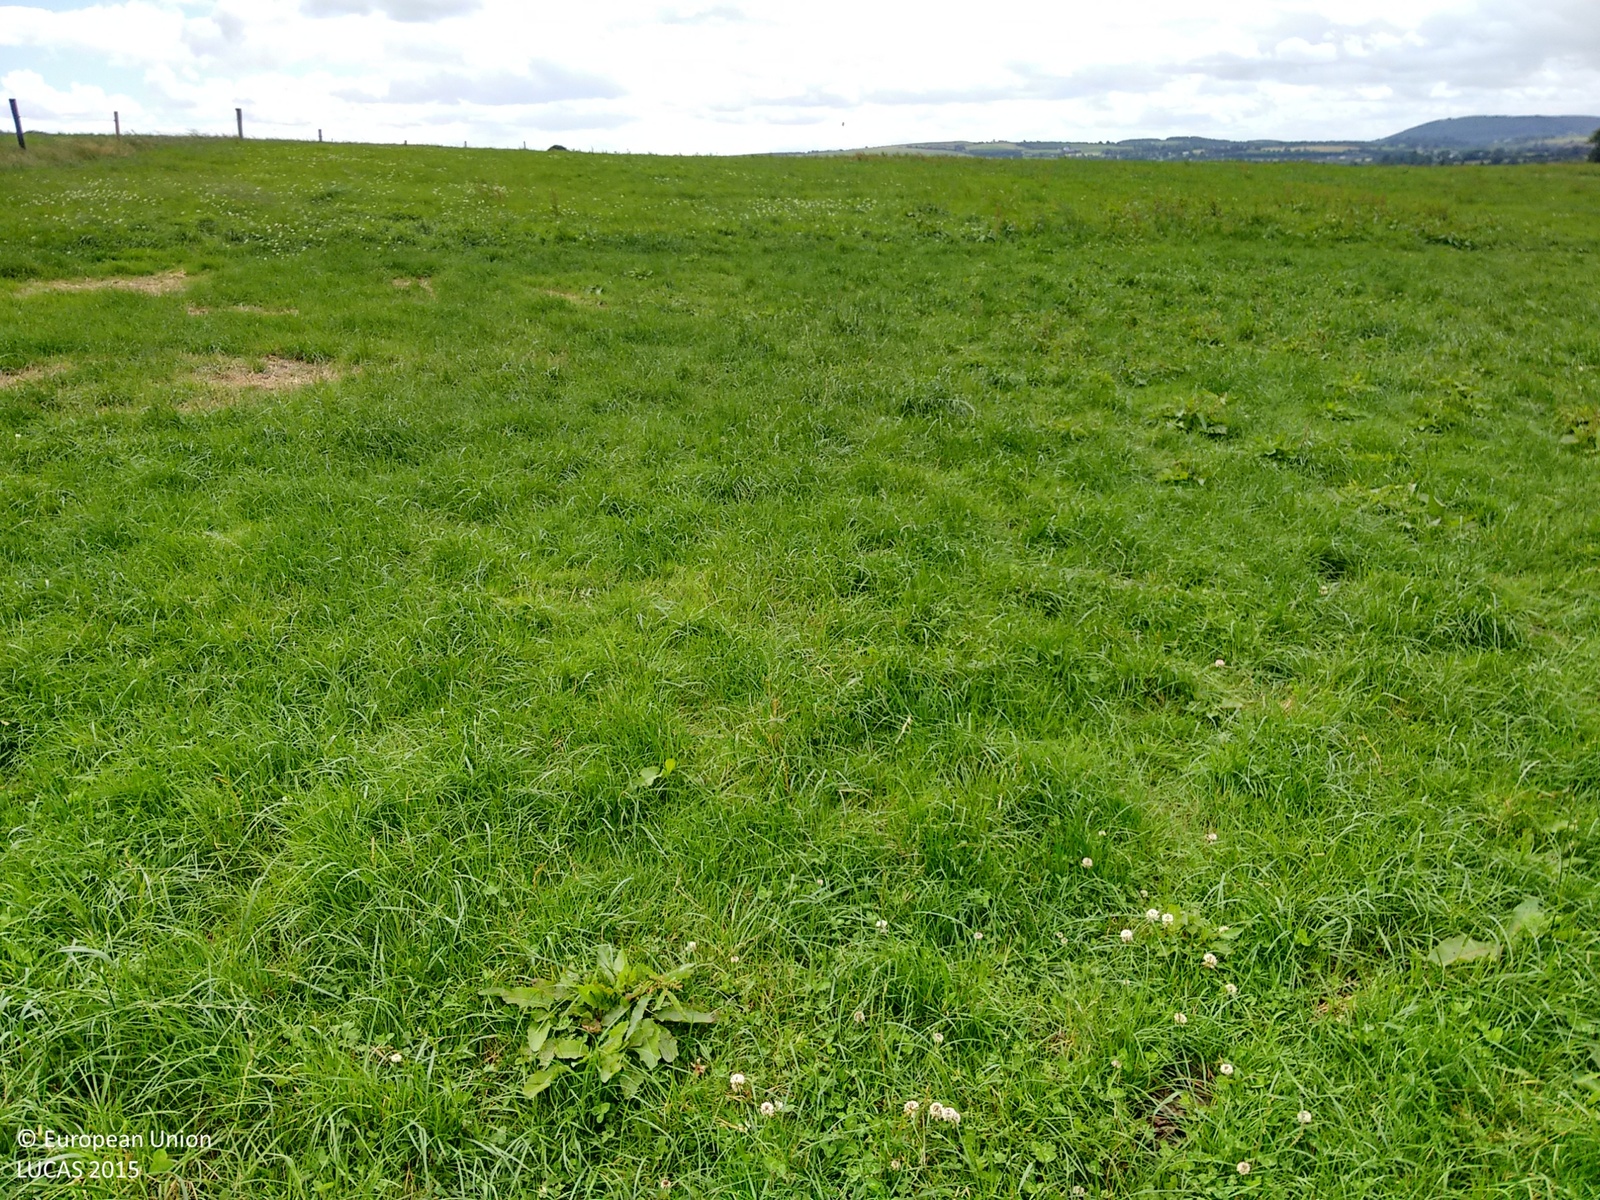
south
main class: Grassland
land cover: Grassland without tree/shrub cover
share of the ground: > 75 %
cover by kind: herbaceous plants 100 %
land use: Agriculture (excluding fallow land and kitchen gardens)
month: July
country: IE
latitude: 52.1692
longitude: -8.2114
